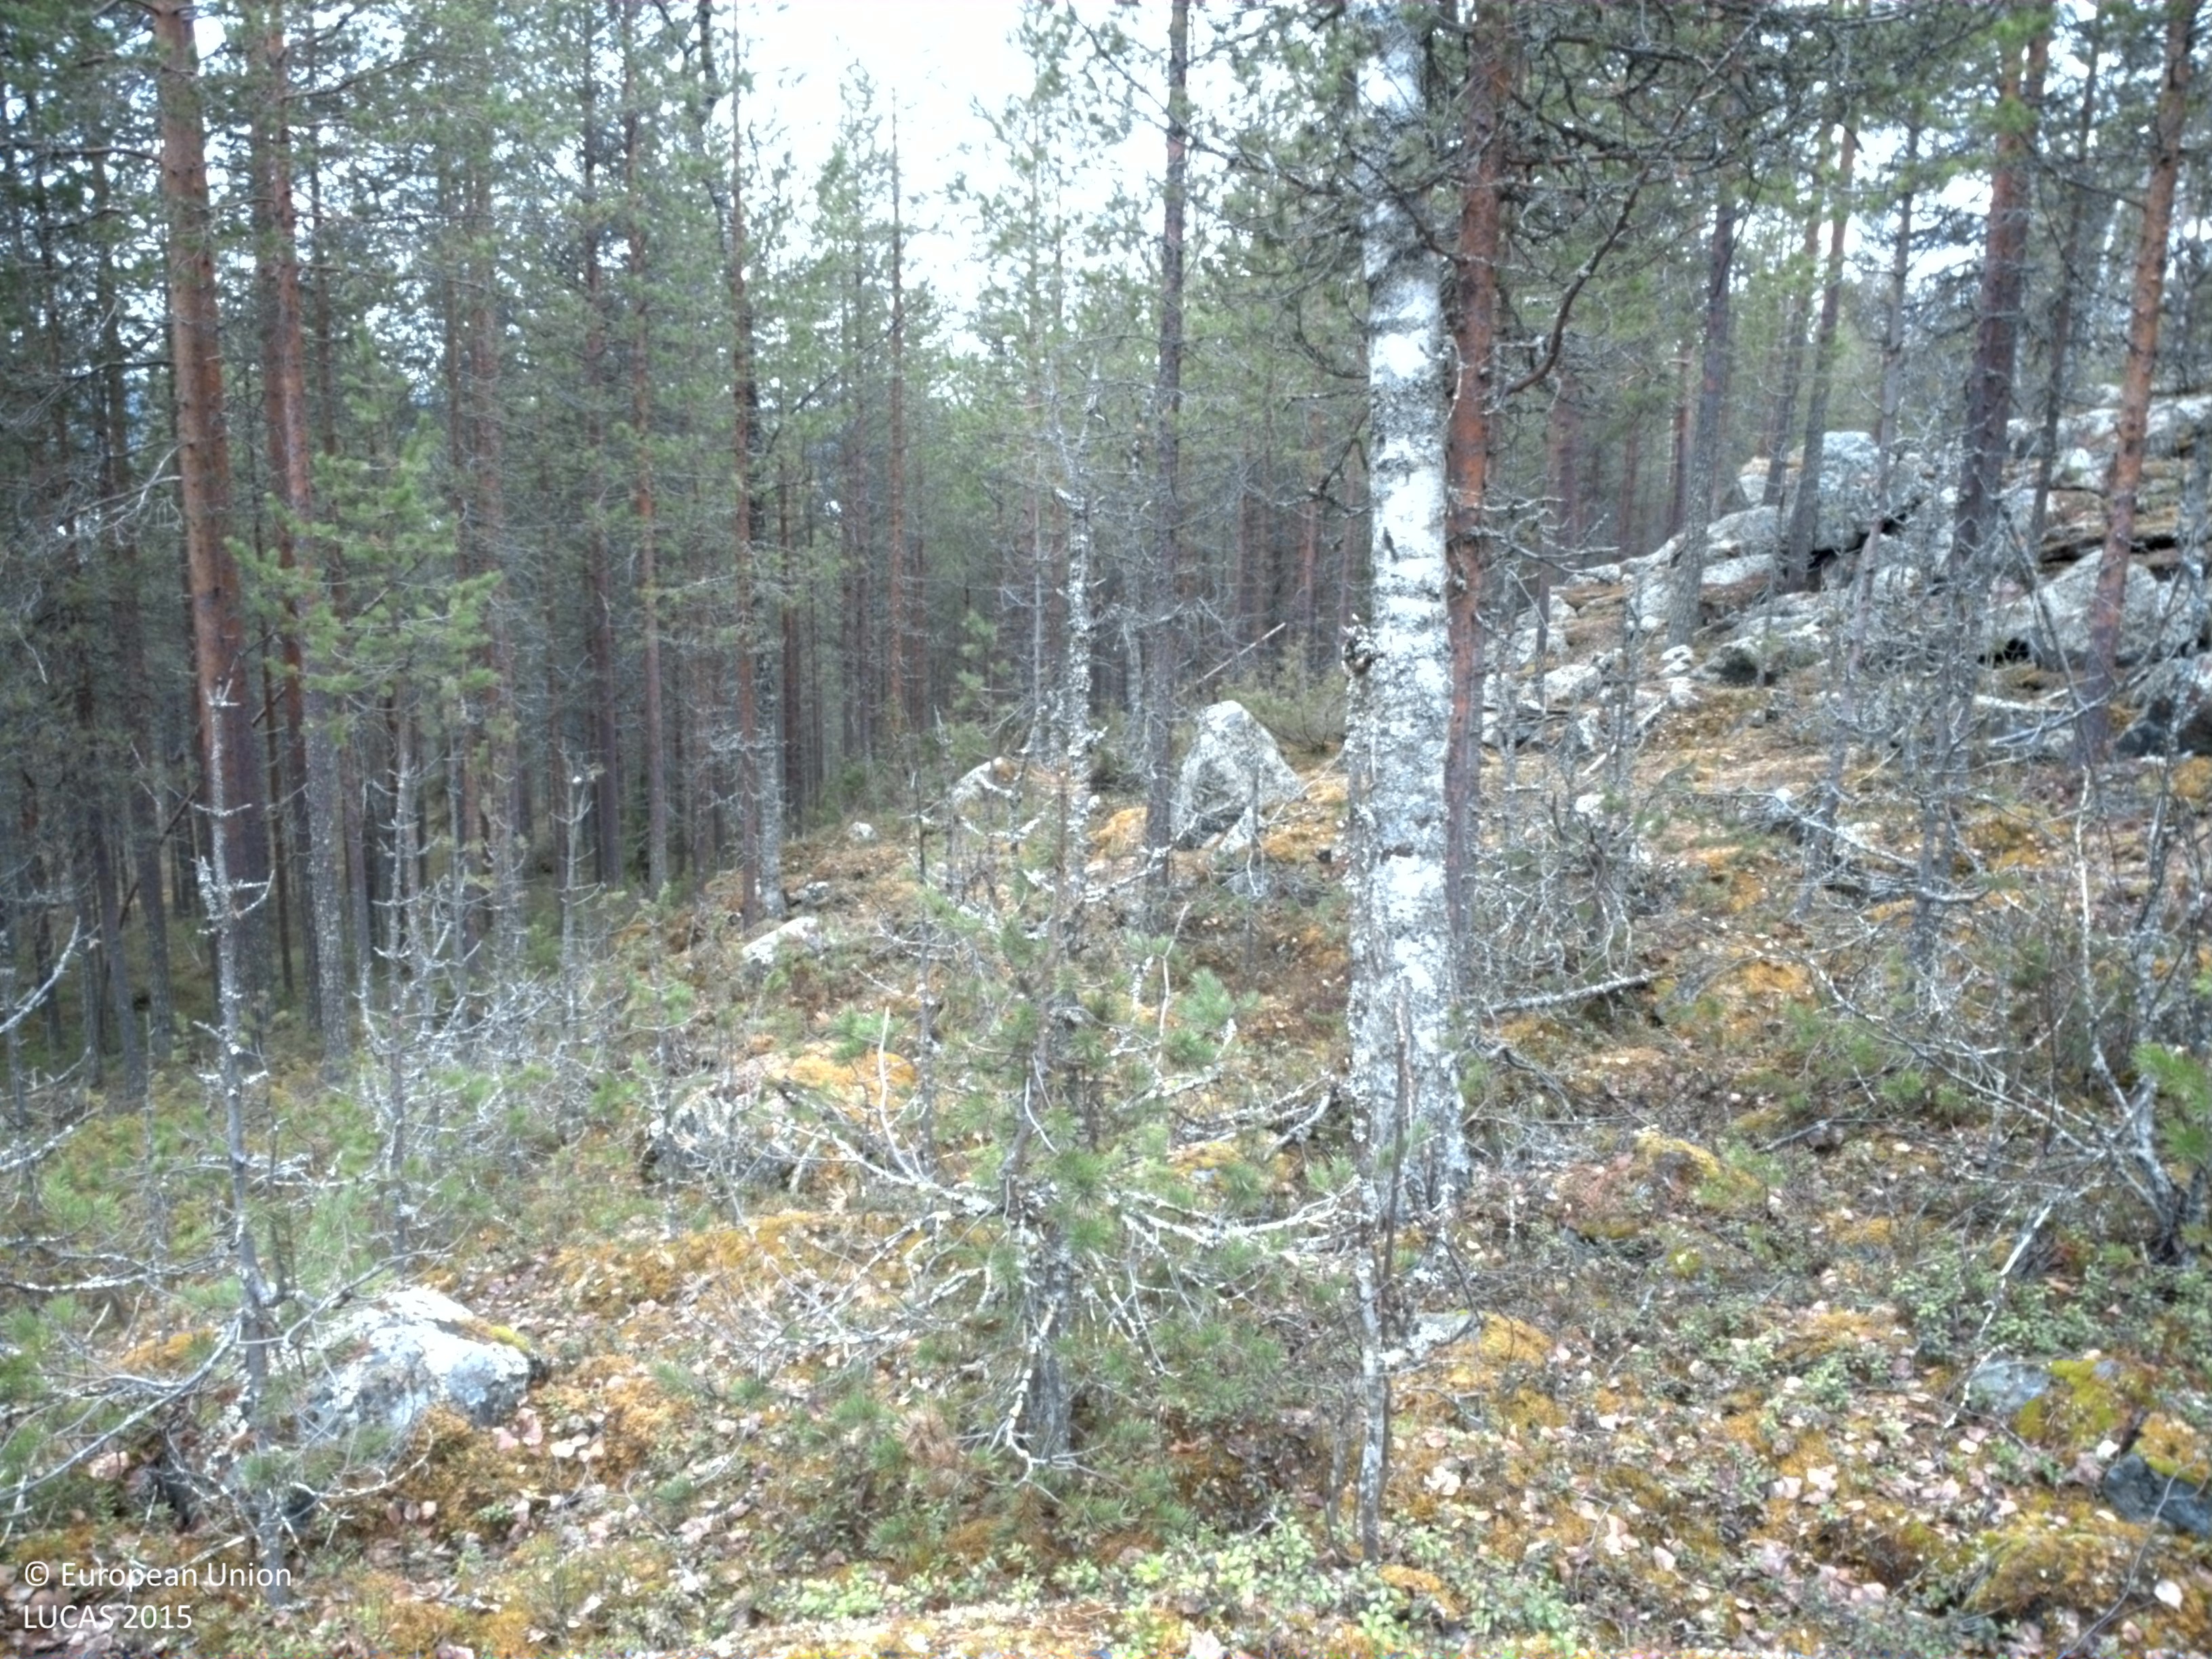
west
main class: Woodland
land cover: Pine dominated coniferous woodland
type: boreal forest
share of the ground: 50 - 75 %
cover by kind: coniferous forest trees 65 %, lichens and mosses 25 %, shrubs 10 %
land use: Forestry
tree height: > 5 m
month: May
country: SE
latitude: 66.4949
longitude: 23.6248
